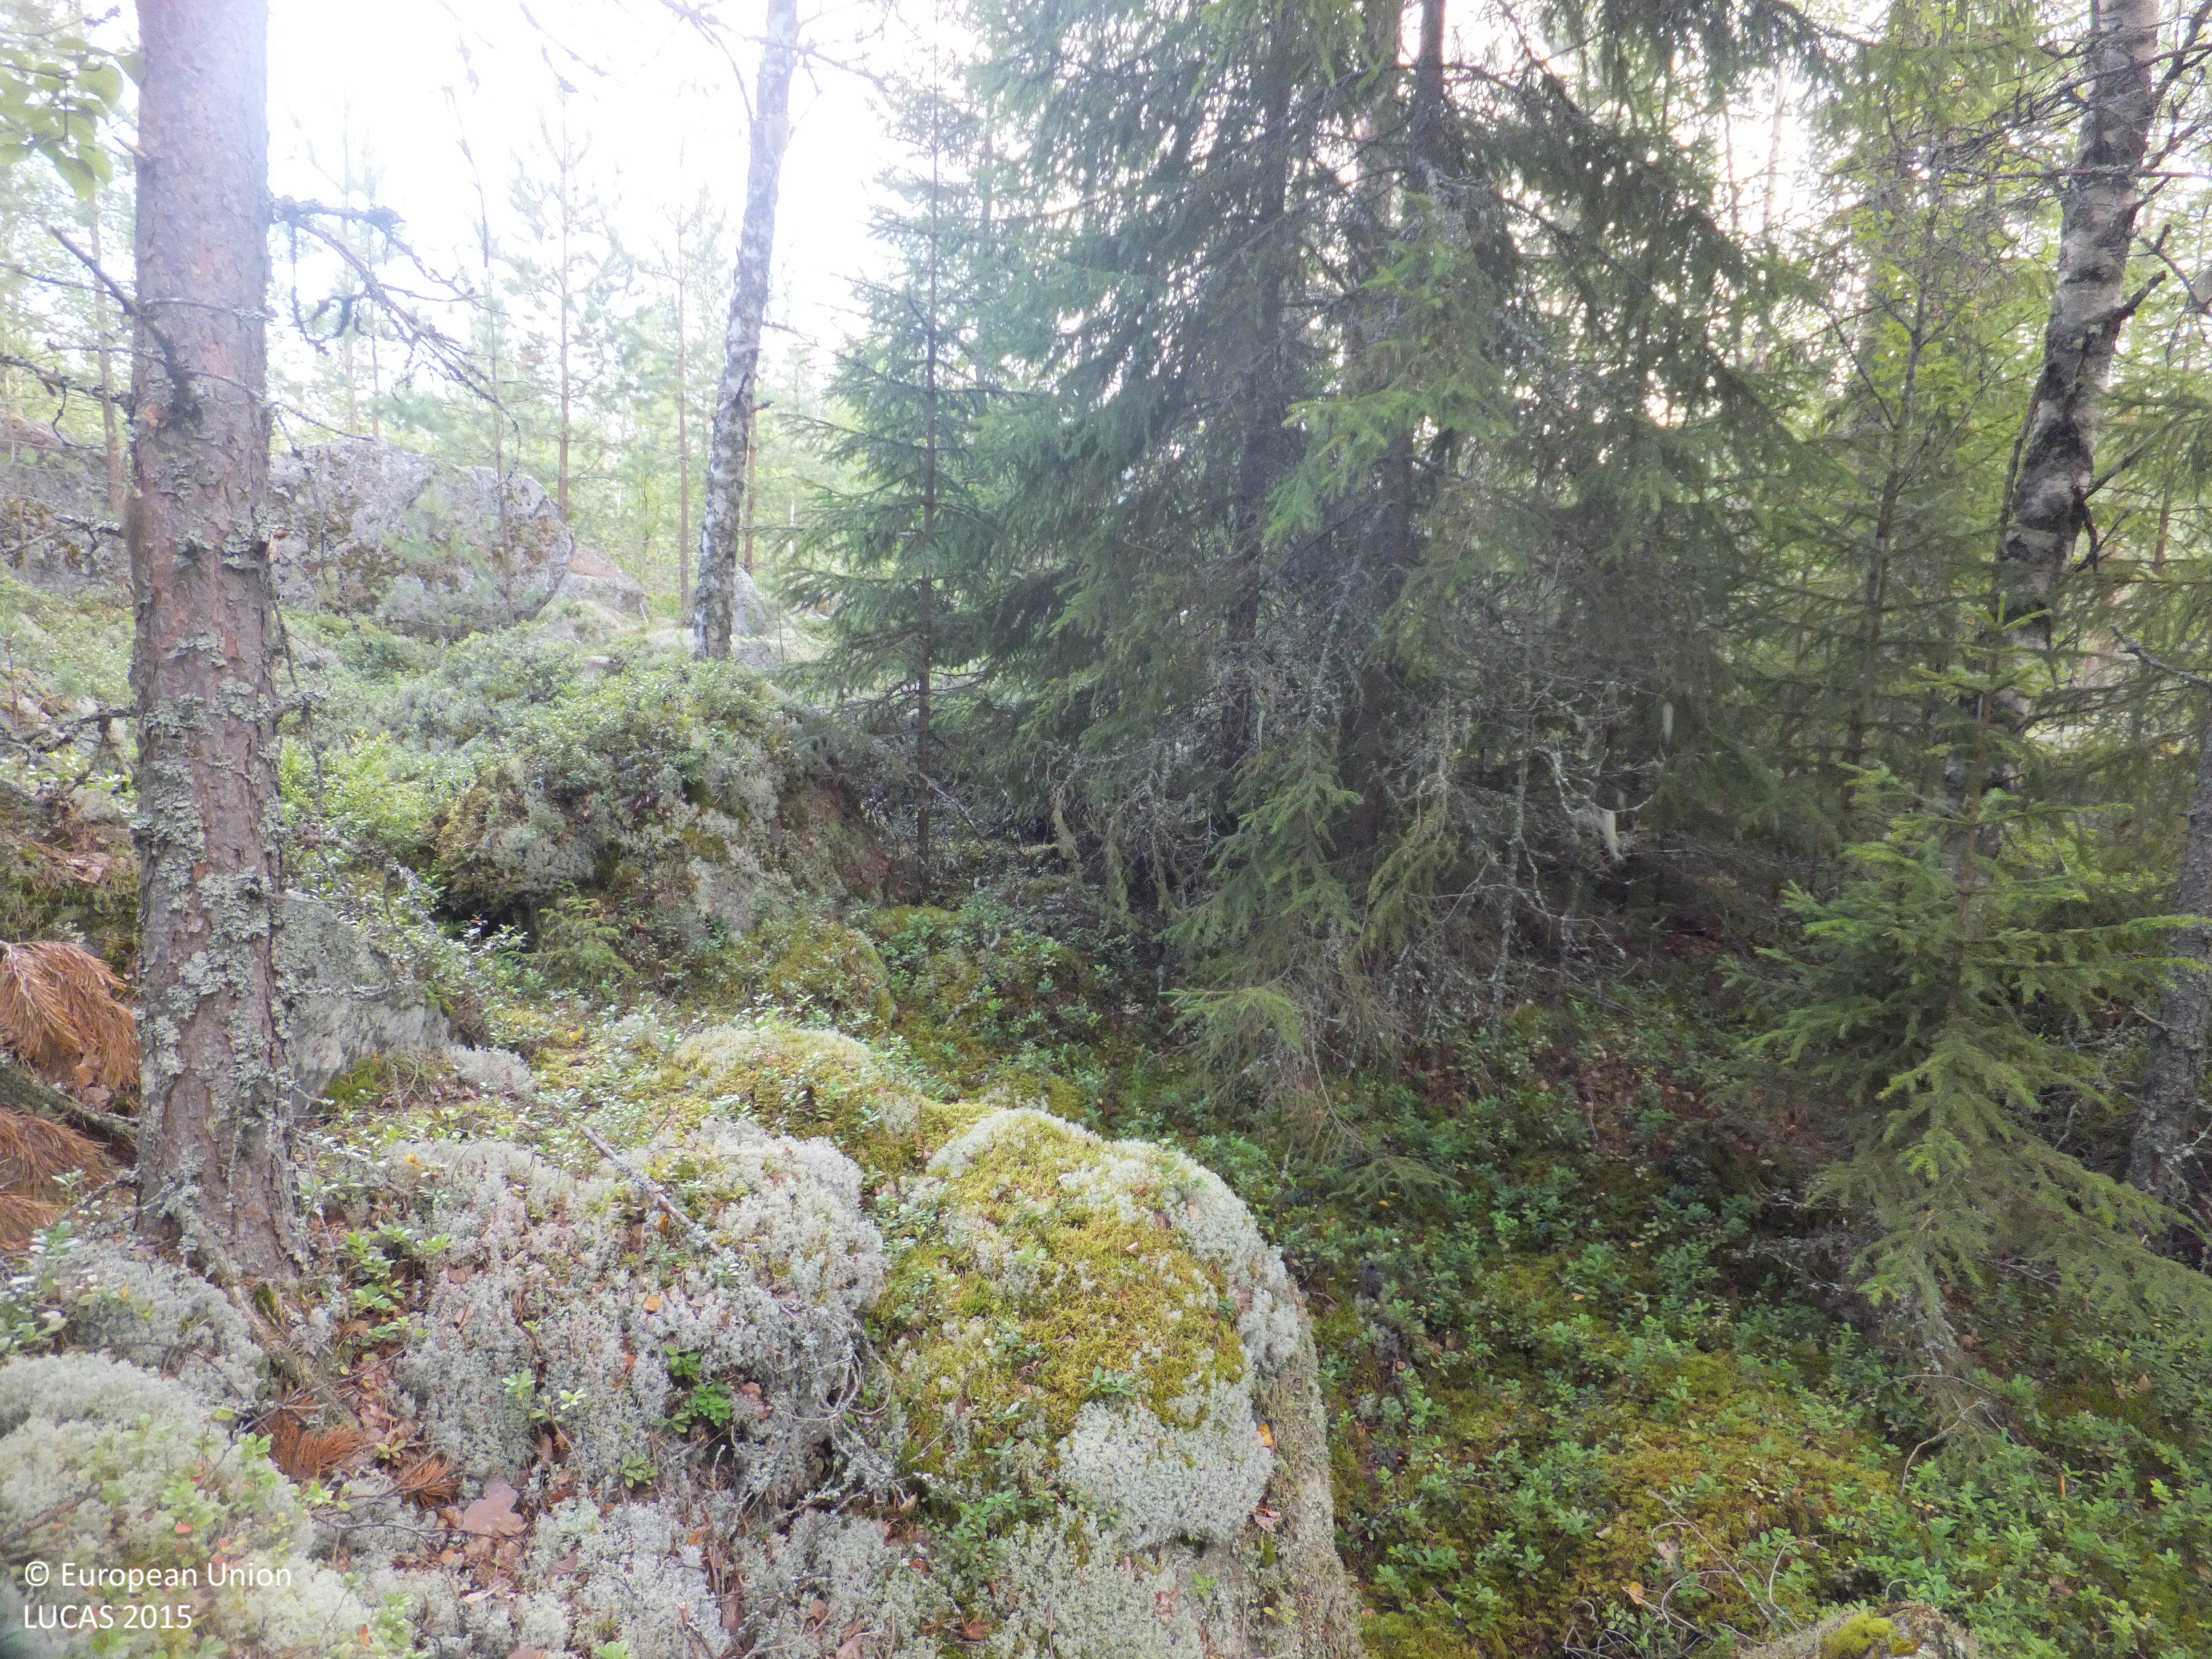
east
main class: Woodland
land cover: Other mixed woodland
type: boreal forest
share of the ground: 50 - 75 %
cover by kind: coniferous forest trees 30 %, broadleaved forest trees 30 %, shrubs 15 %, lichens and mosses 15 %, consolidated bare surface 10 %
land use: Forestry
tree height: > 5 m
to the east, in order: Other mixed woodland; Pine dominated mixed woodland; Ditches and canals; Pine dominated coniferous woodland; Ditches and canals; Pine dominated mixed woodland; Pine dominated coniferous woodland; Other mixed woodland; Ditches and canals; Other mixed woodland
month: July
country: FI
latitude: 63.2296
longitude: 22.2047
